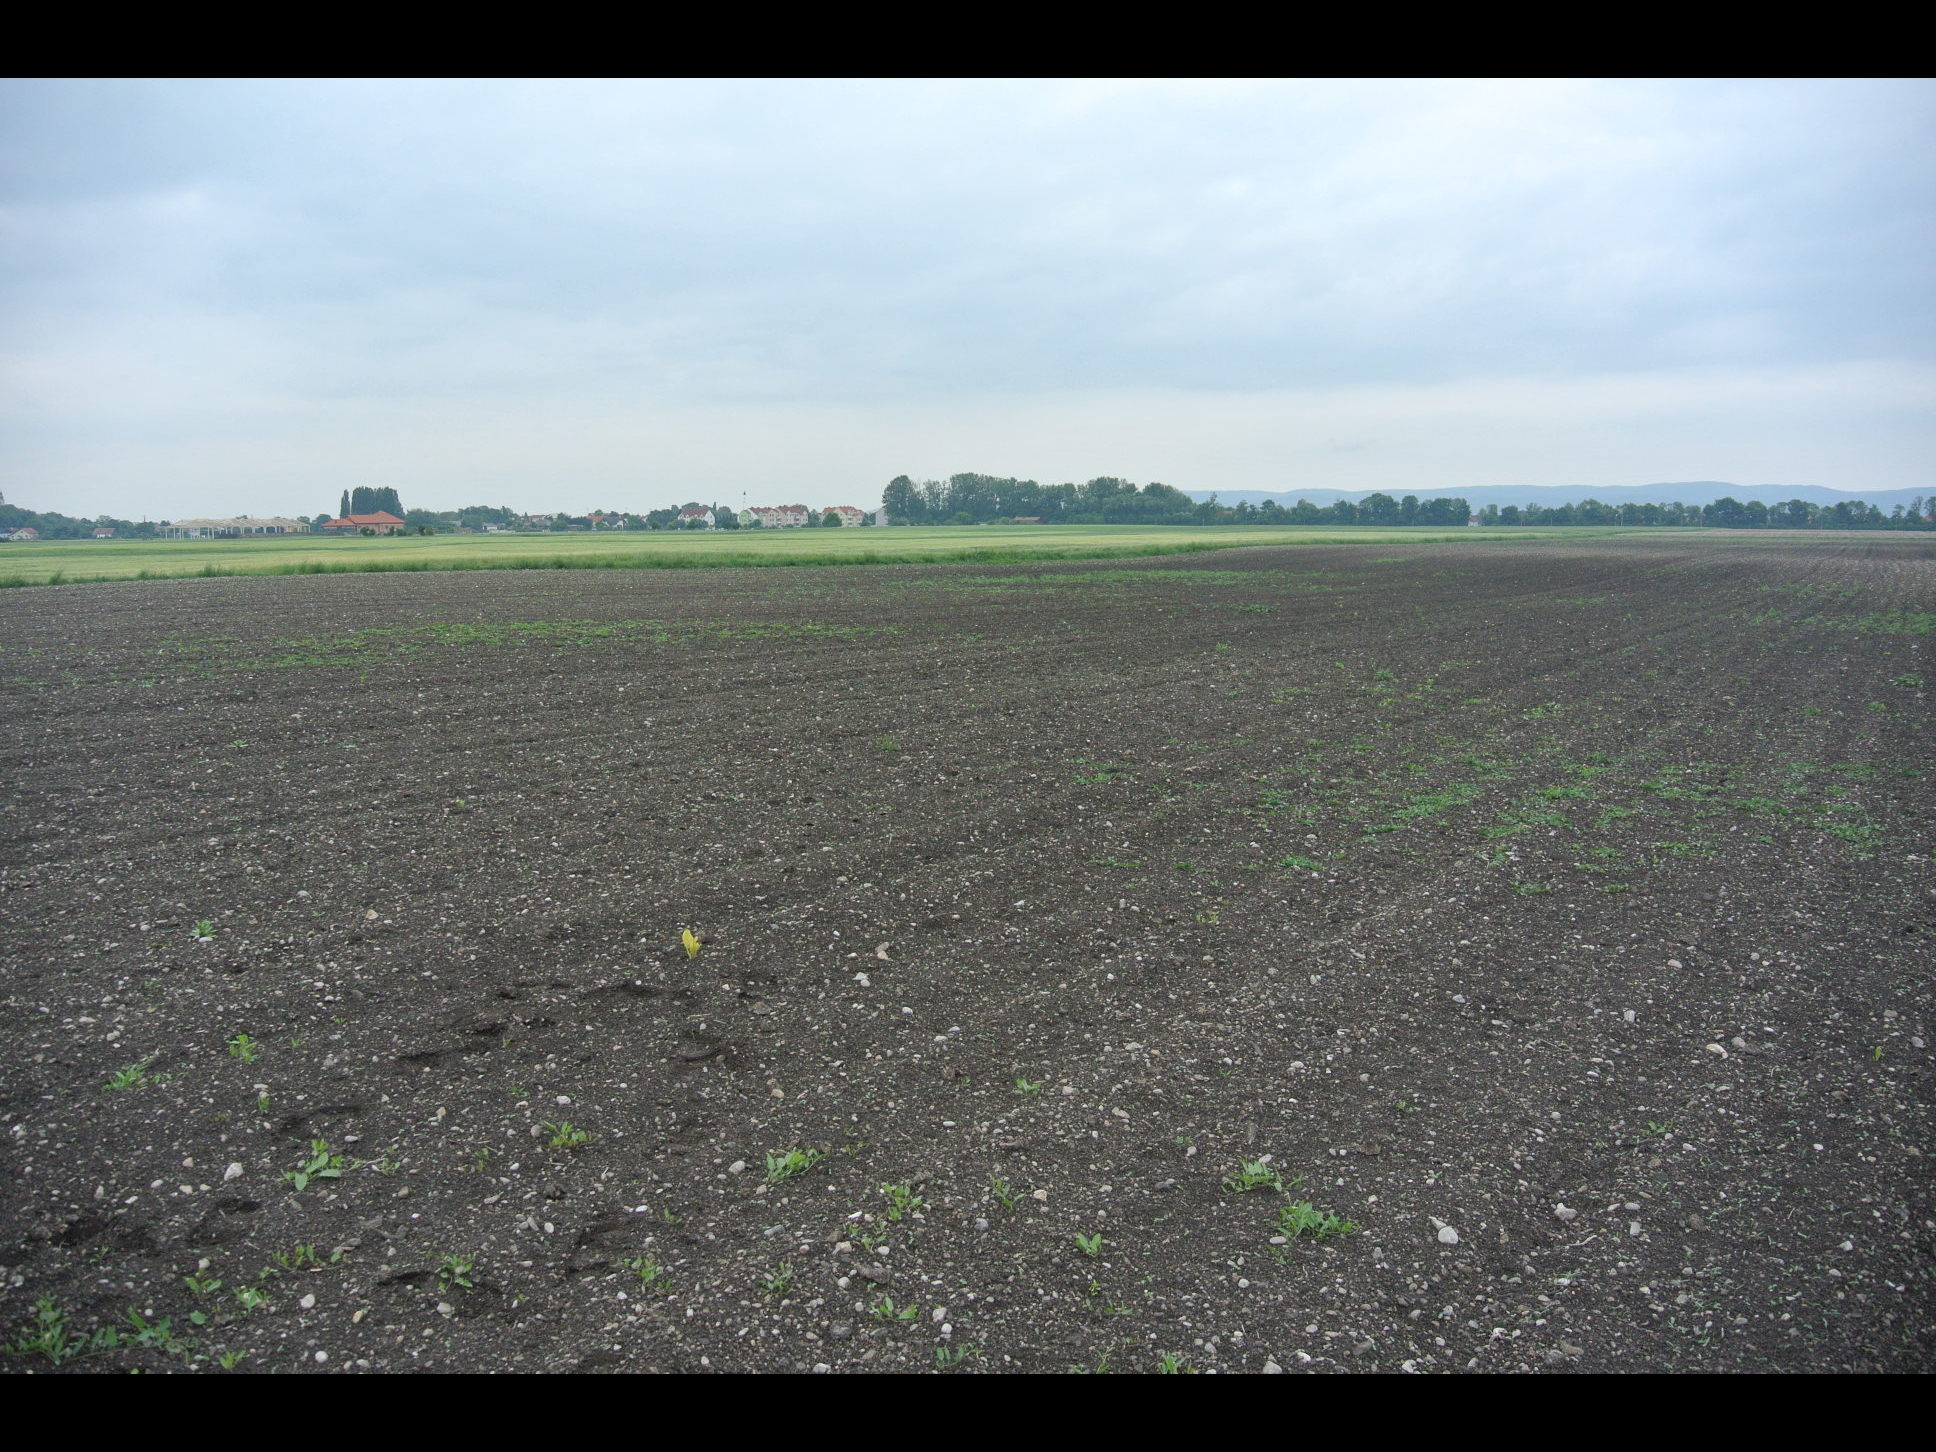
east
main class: Cropland
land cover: Sunflower
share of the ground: > 75 %
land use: Agriculture (excluding fallow land and kitchen gardens)
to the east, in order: Sunflower; Tracks; Oats; Common wheat
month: May
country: AT
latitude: 47.9953
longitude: 16.5047
